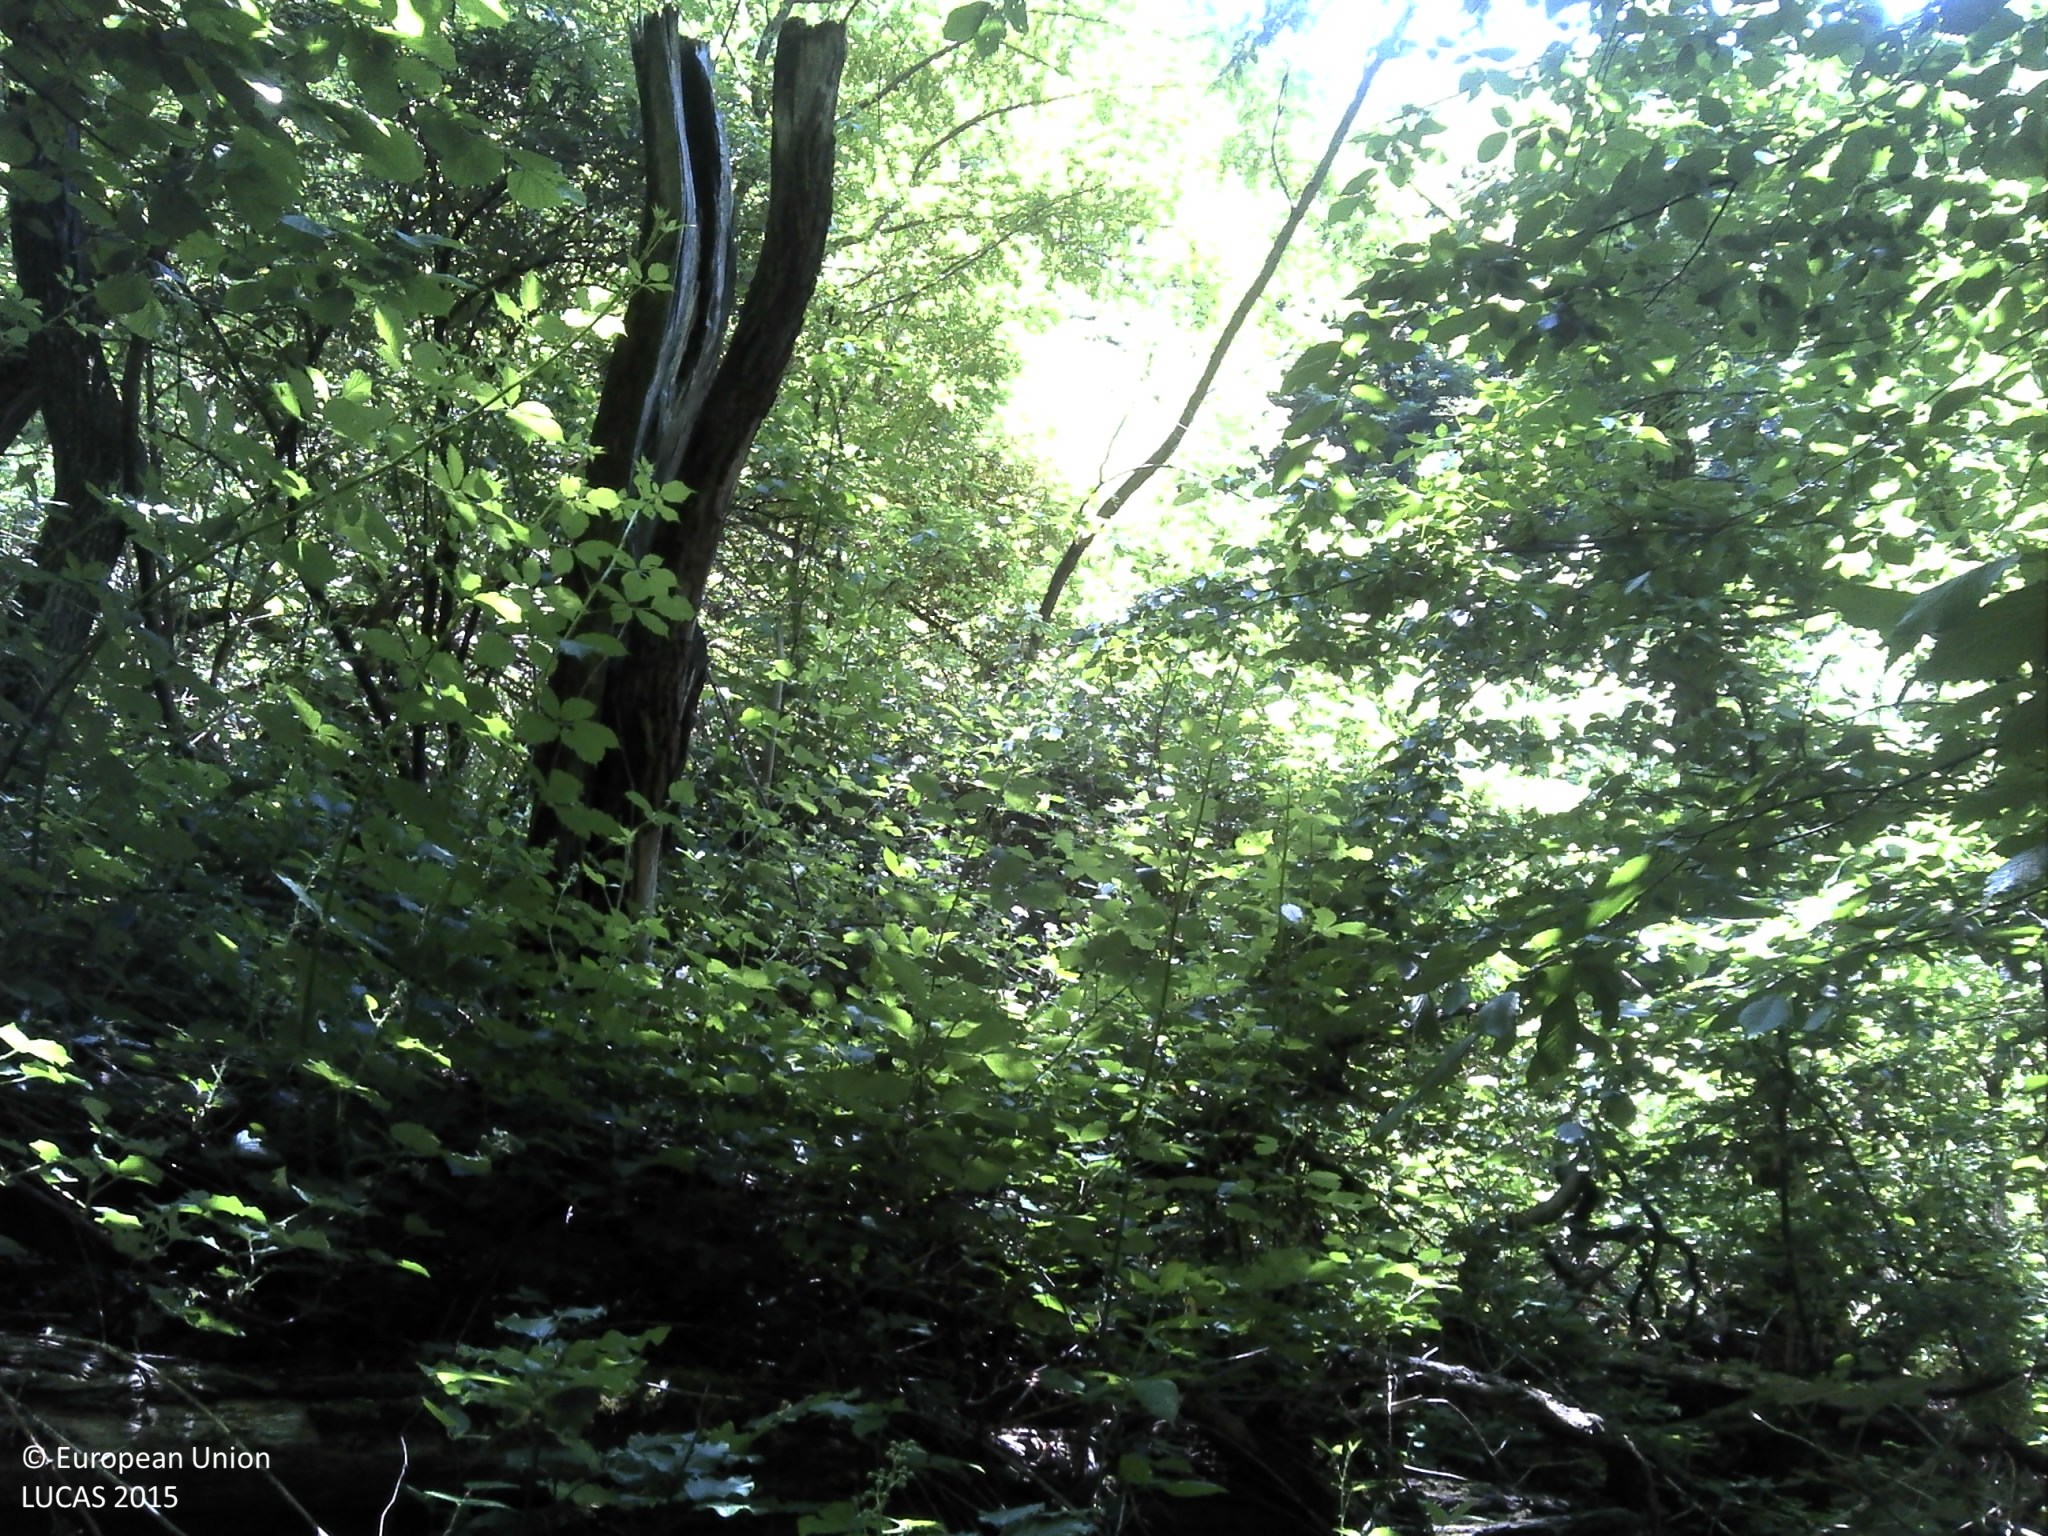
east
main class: Woodland
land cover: Broadleaved woodland
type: acidophilous oak and oak-birch forest
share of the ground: > 75 %
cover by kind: broadleaved forest trees 80 %, lichens and mosses 20 %
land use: Forestry
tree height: > 5 m
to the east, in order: Broadleaved woodland
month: June
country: HR
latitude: 45.4676
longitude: 17.8176
